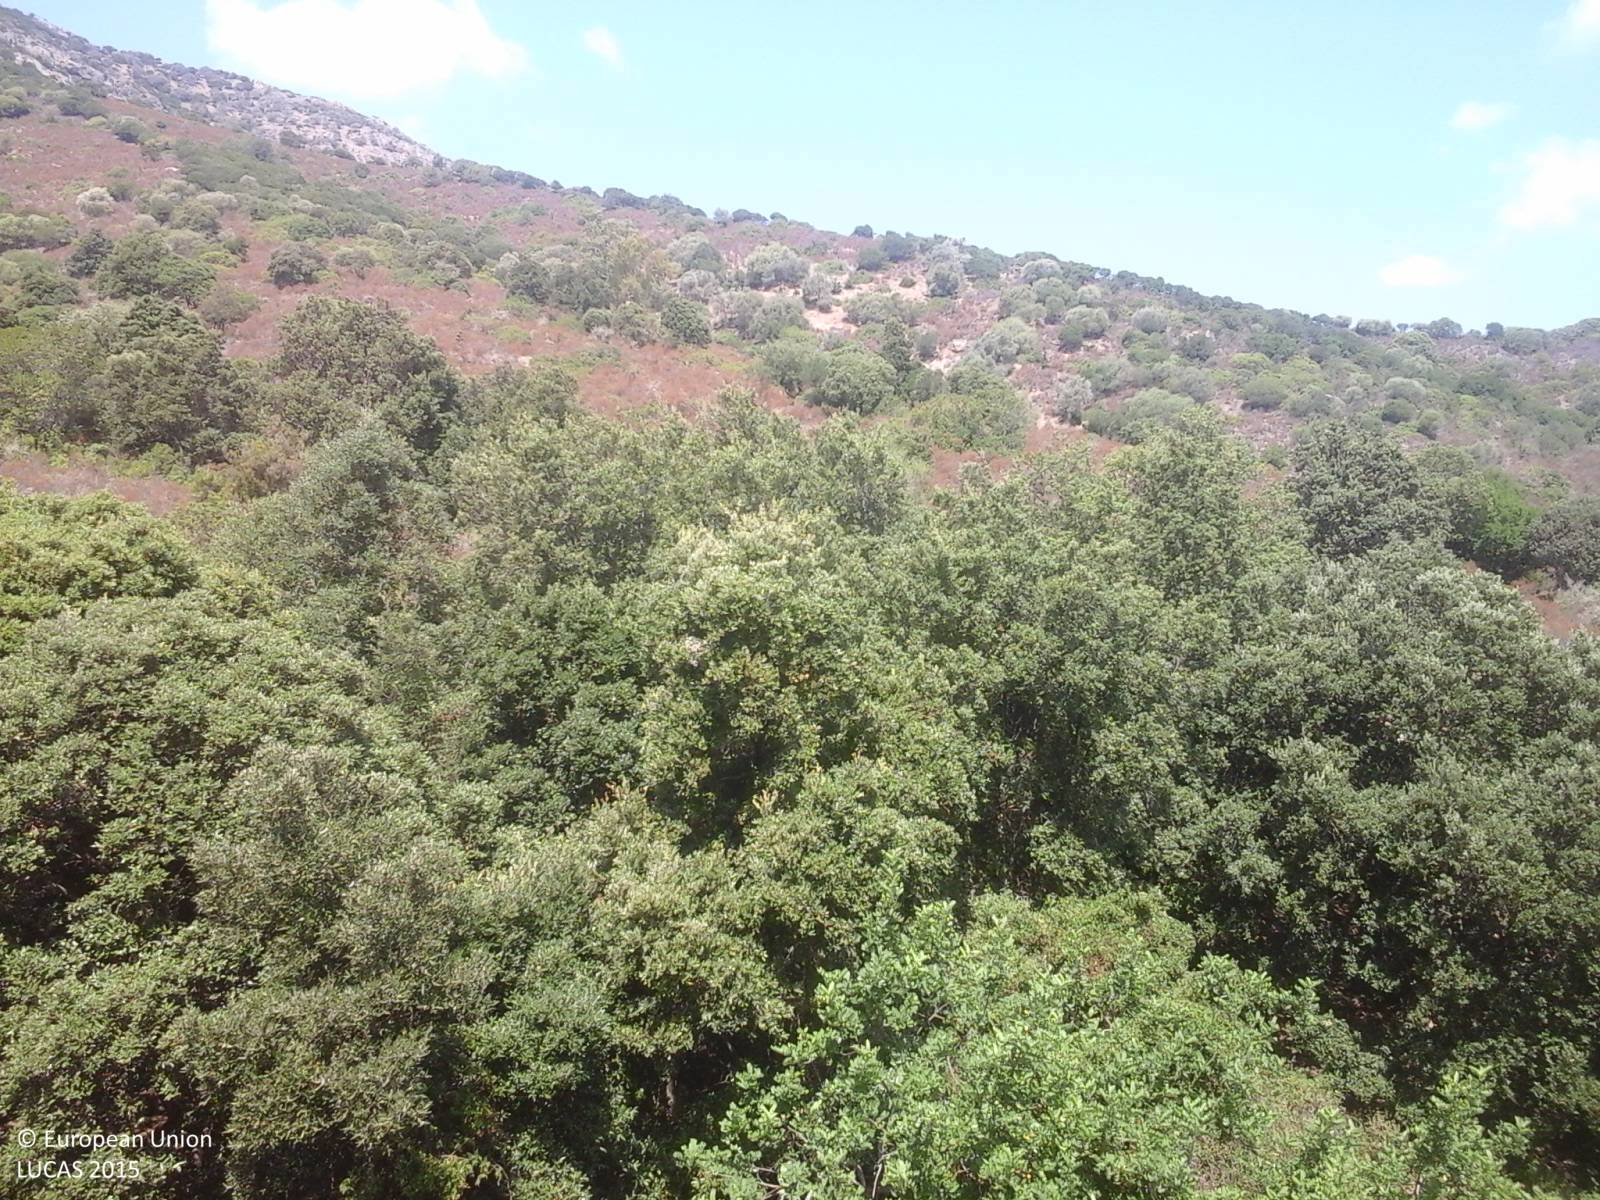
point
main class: Shrubland
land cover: Shrubland with sparse tree cover
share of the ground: > 75 %
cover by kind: shrubs 75 %, herbaceous plants 15 %, broadleaved forest trees 5 %, unconsolidated bare surface 5 %
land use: Agriculture (excluding fallow land and kitchen gardens)
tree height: < 5 m
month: July
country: IT
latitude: 39.4331
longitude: 9.5265
